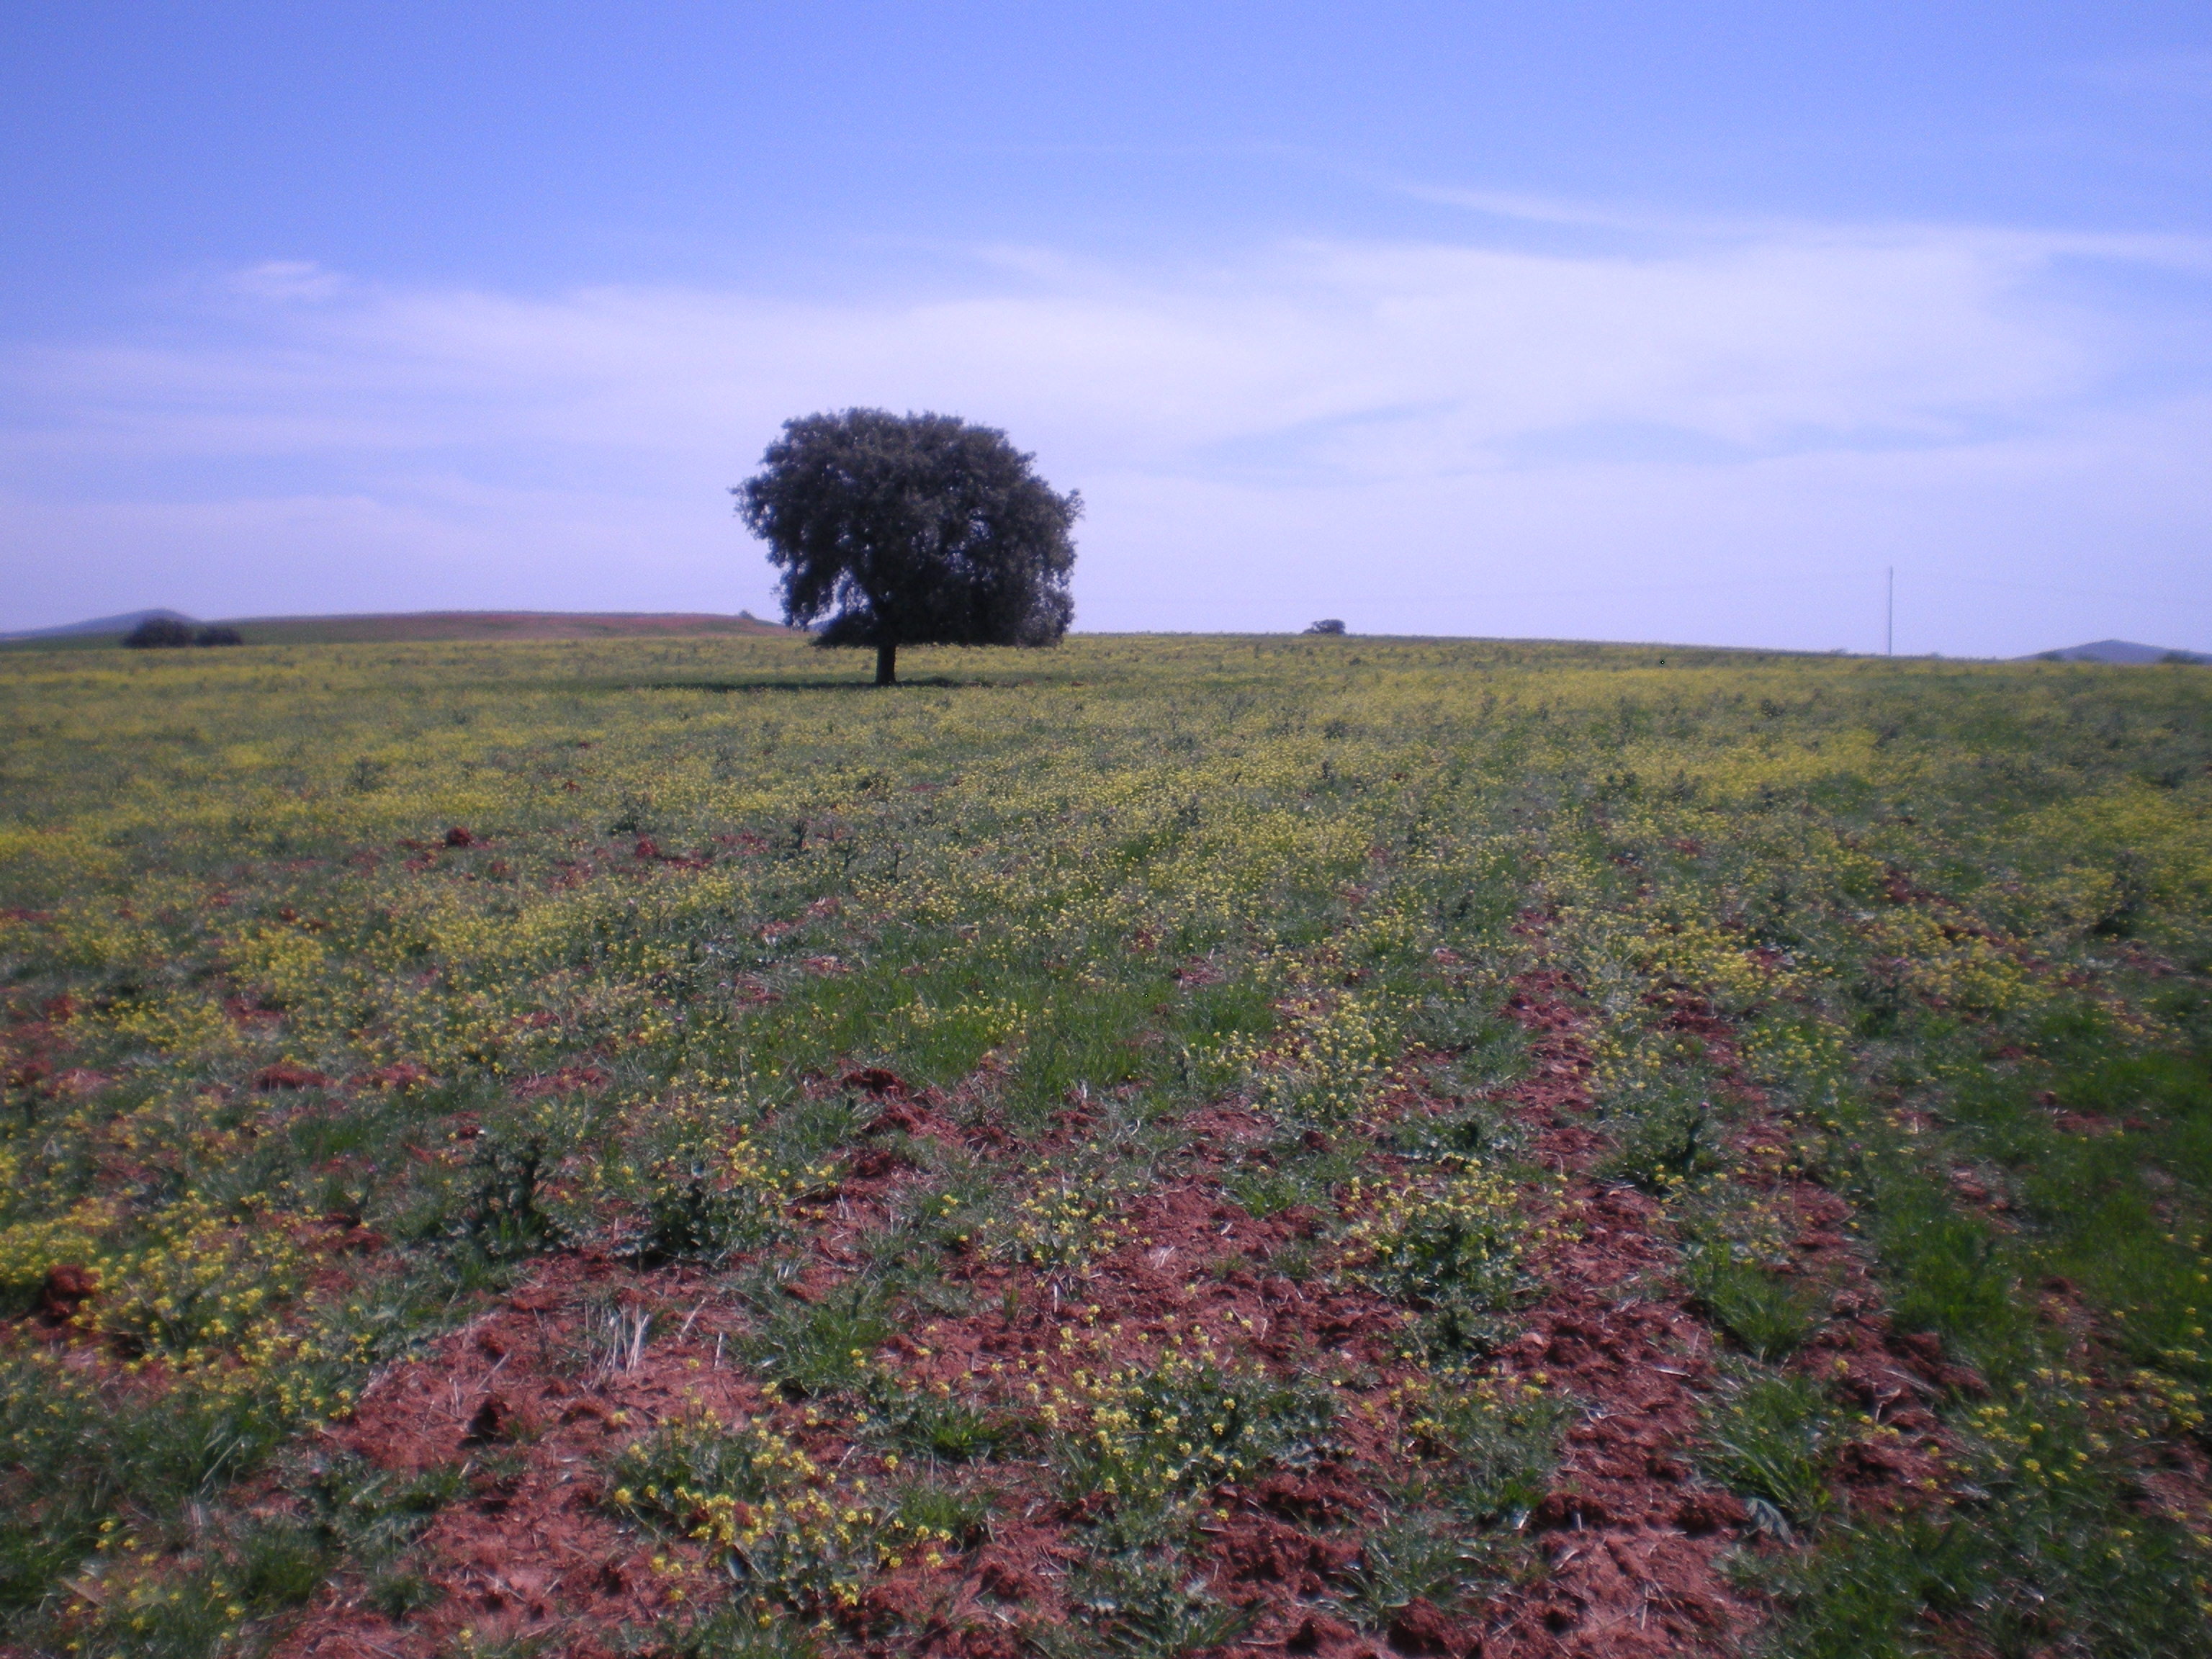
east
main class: Grassland
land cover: Spontaneously vegetated surfaces
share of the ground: > 75 %
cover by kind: unconsolidated bare surface 60 %, herbaceous plants 40 %
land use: Agriculture (excluding fallow land and kitchen gardens)
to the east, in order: Spontaneously vegetated surfaces
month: April
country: ES
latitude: 38.5429
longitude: -3.4900
